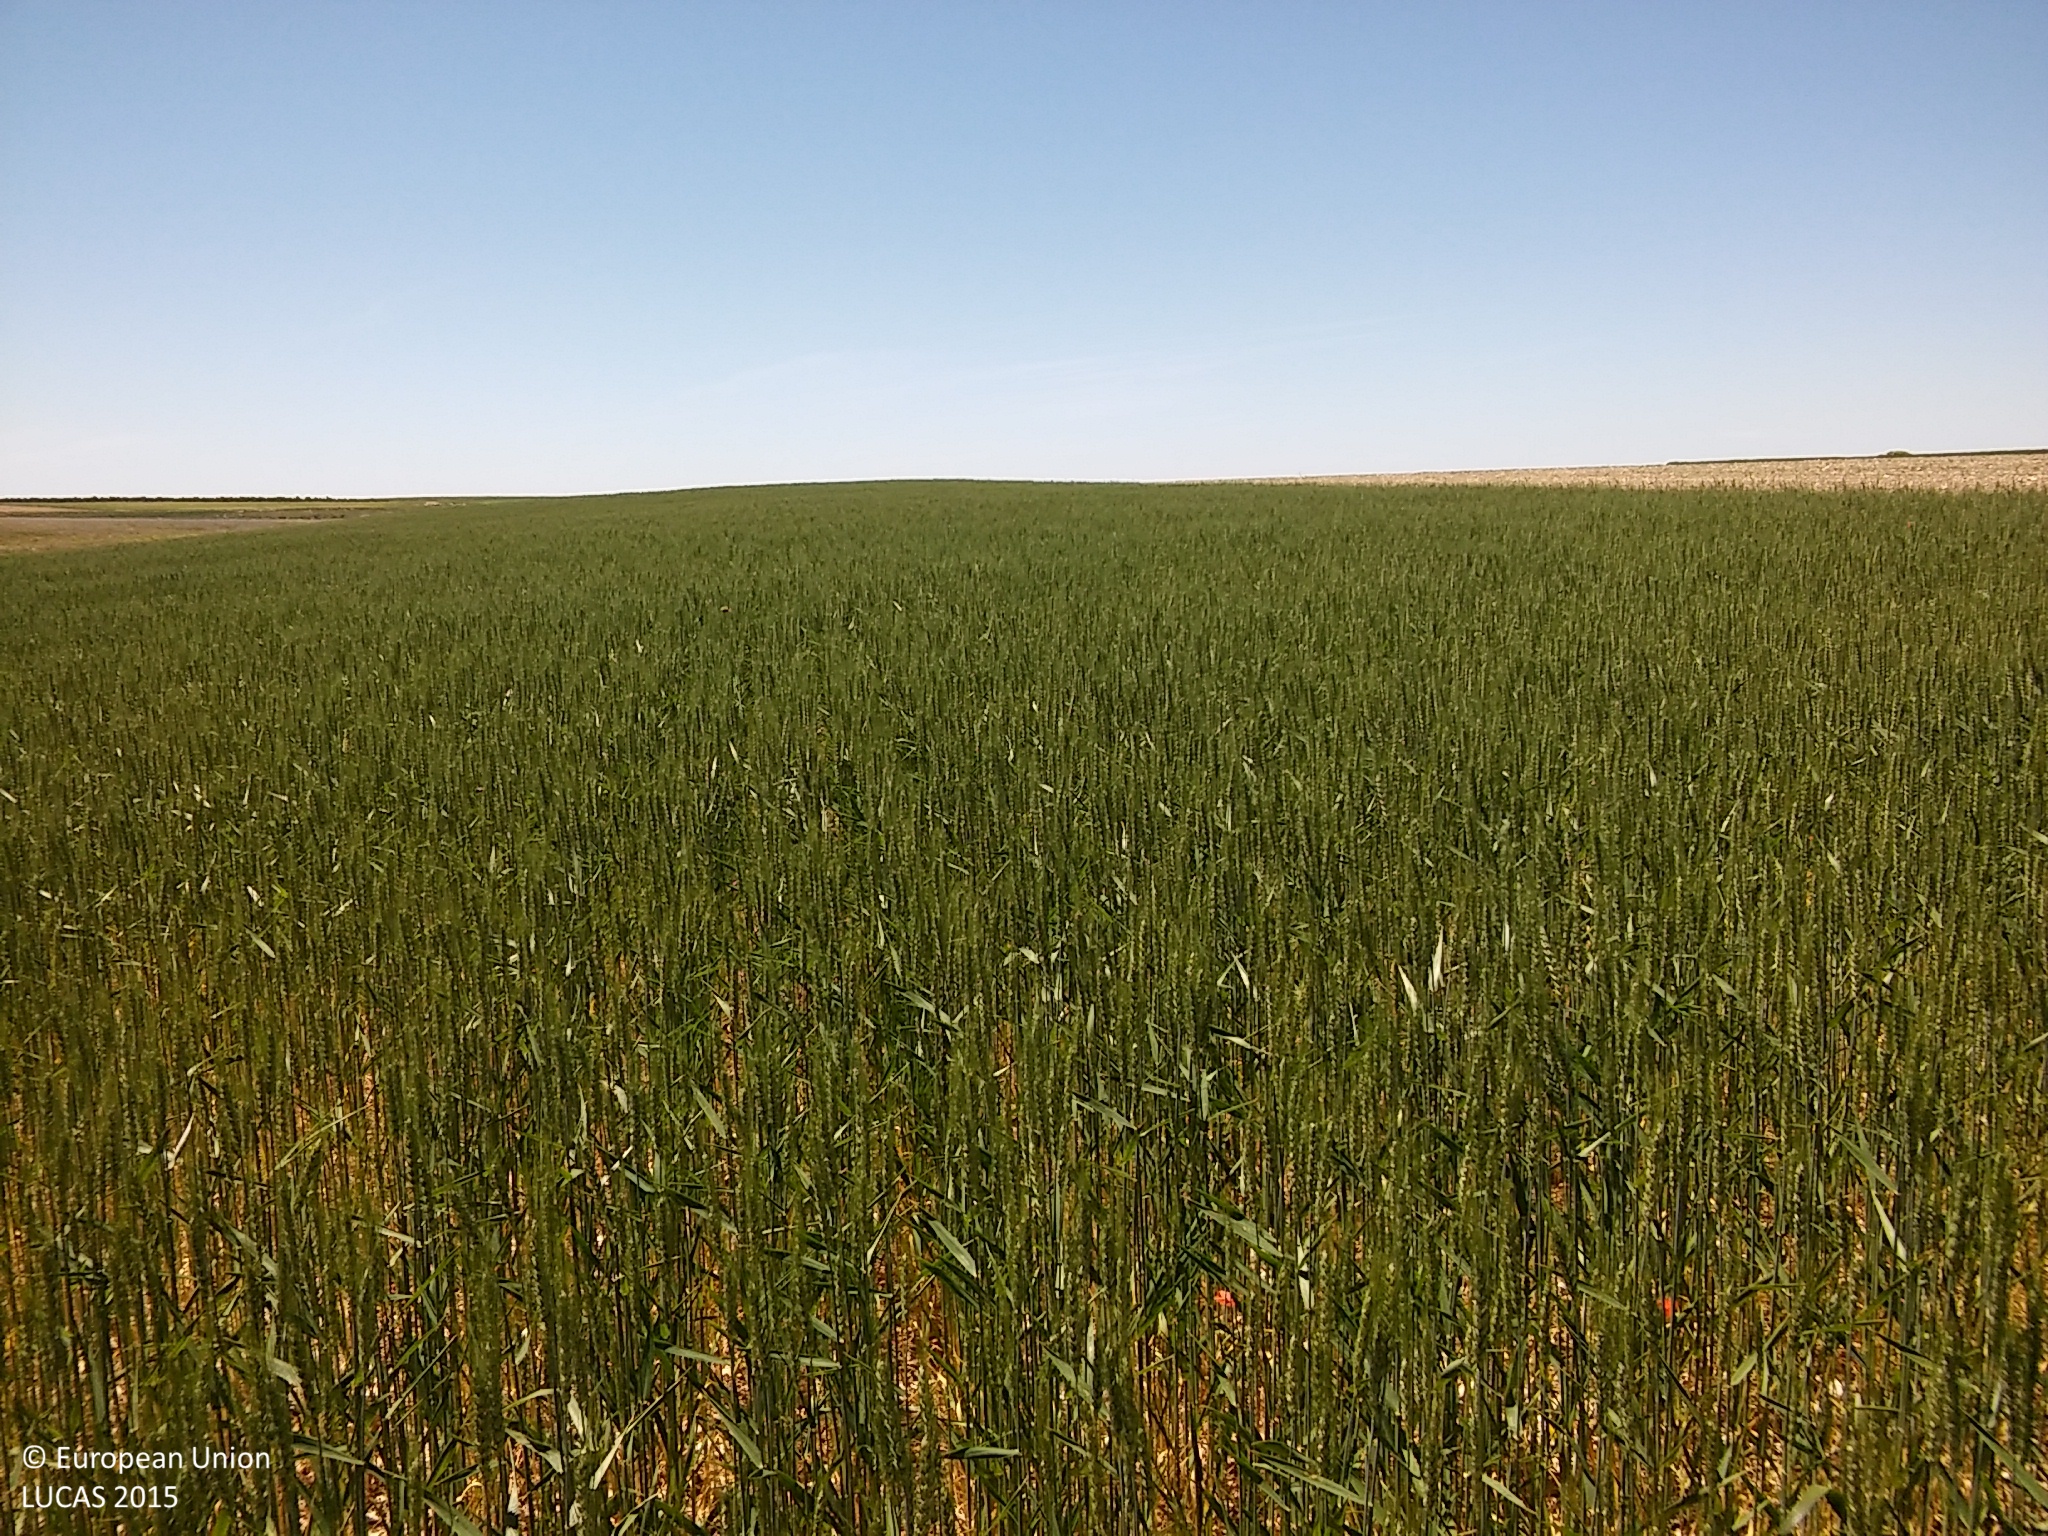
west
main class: Cropland
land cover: Common wheat
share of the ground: > 75 %
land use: Agriculture (excluding fallow land and kitchen gardens)
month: May
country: ES
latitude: 41.4708
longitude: -4.0292
